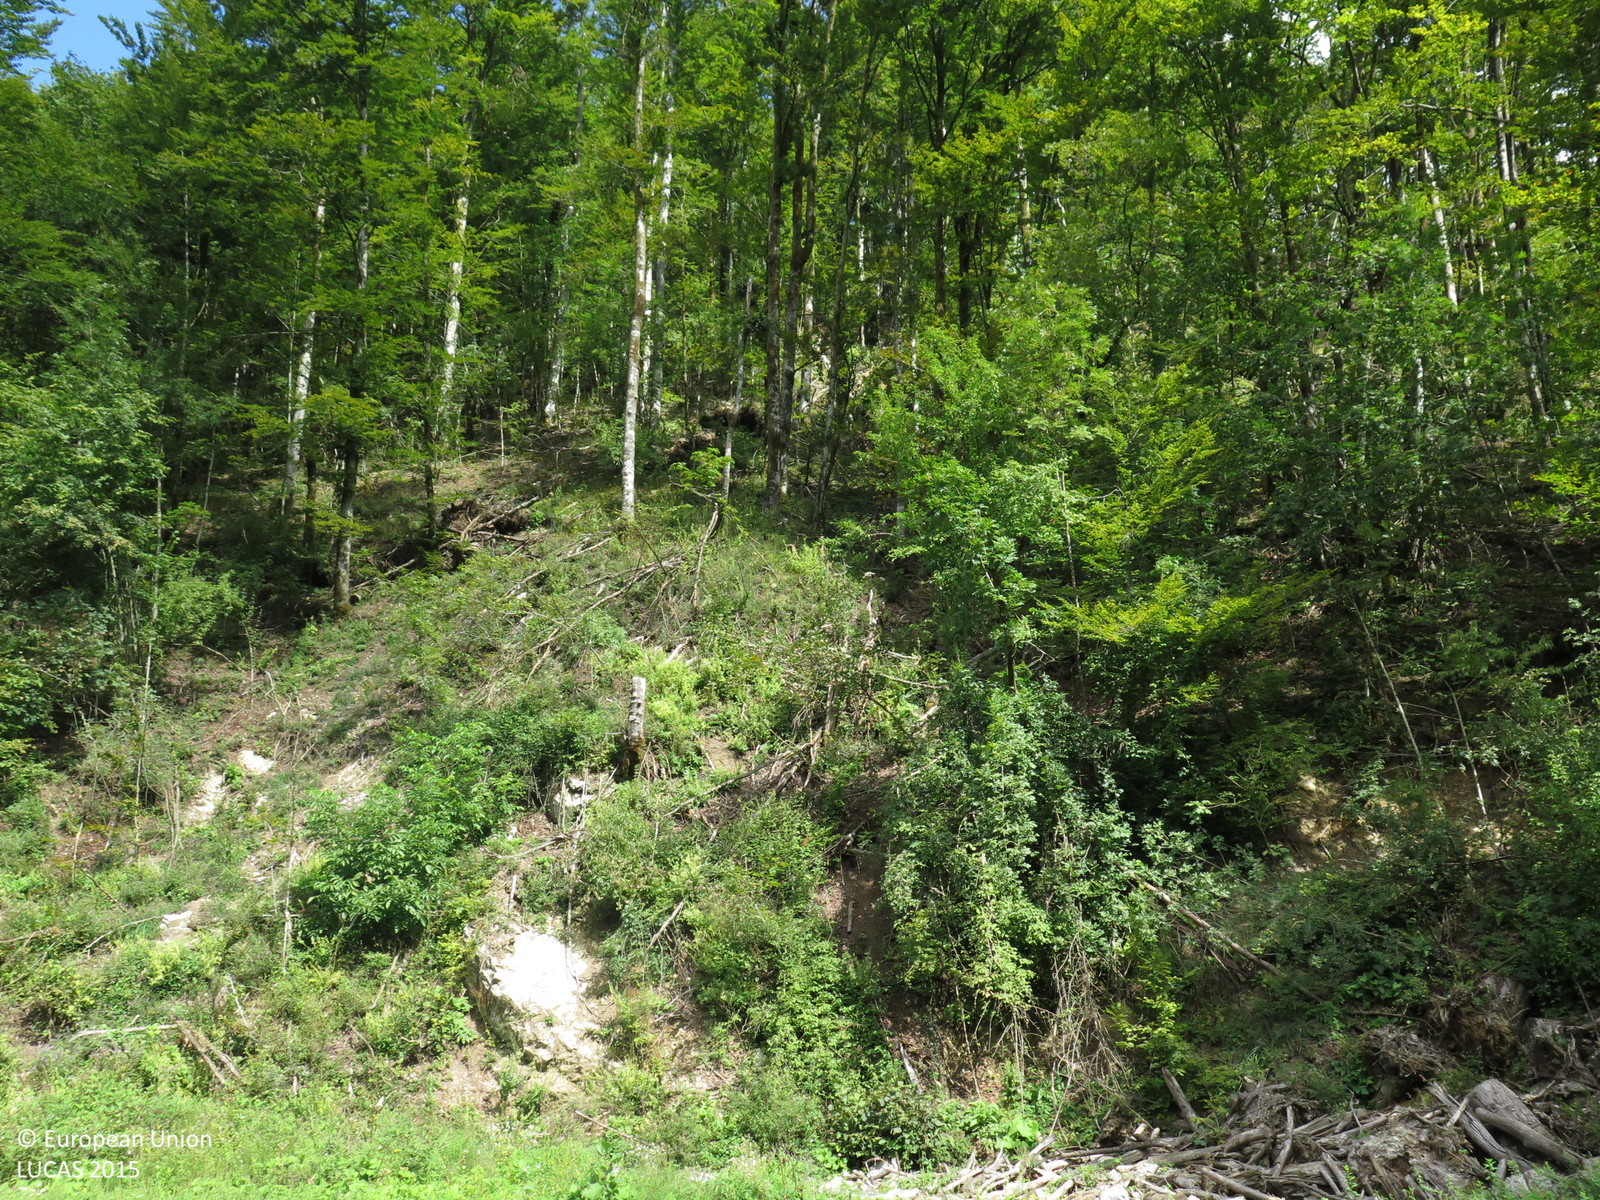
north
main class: Woodland
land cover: Broadleaved woodland
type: beech forest
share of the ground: > 75 %
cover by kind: broadleaved forest trees 90 %, shrubs 5 %, herbaceous plants 5 %
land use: Forestry
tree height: > 5 m
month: September
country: HR
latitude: 45.4870
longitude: 14.7679
